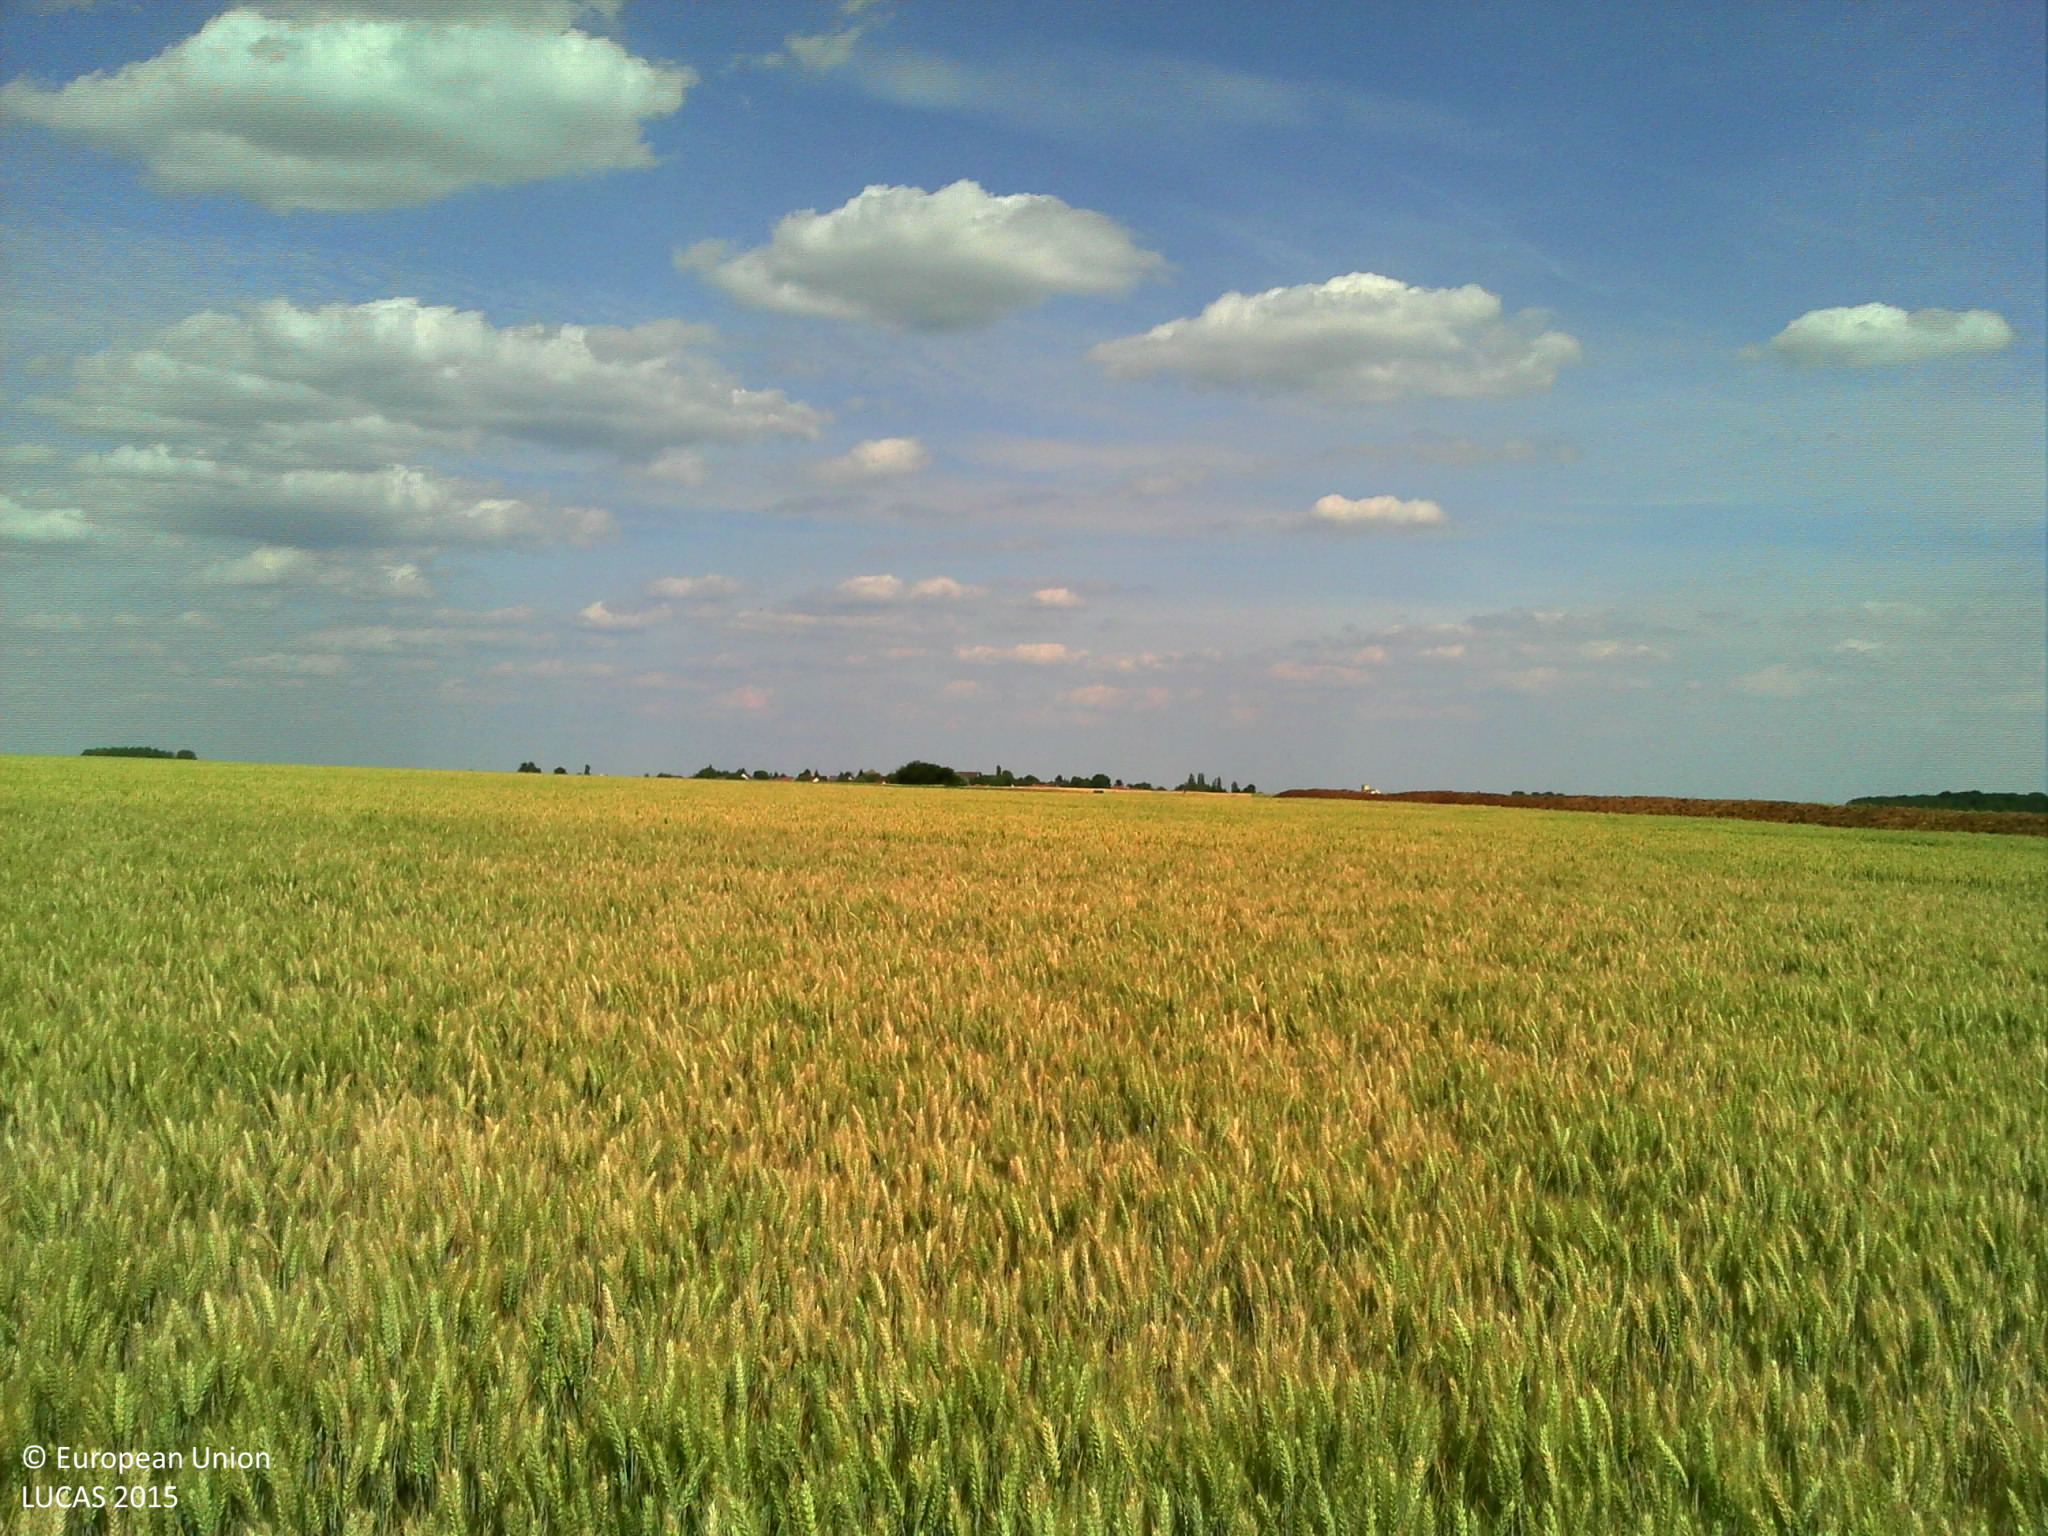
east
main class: Cropland
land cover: Common wheat
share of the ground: > 75 %
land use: Agriculture (excluding fallow land and kitchen gardens)
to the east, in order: Common wheat; Sugar beet
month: June
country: FR
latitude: 49.3974
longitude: 2.5338
